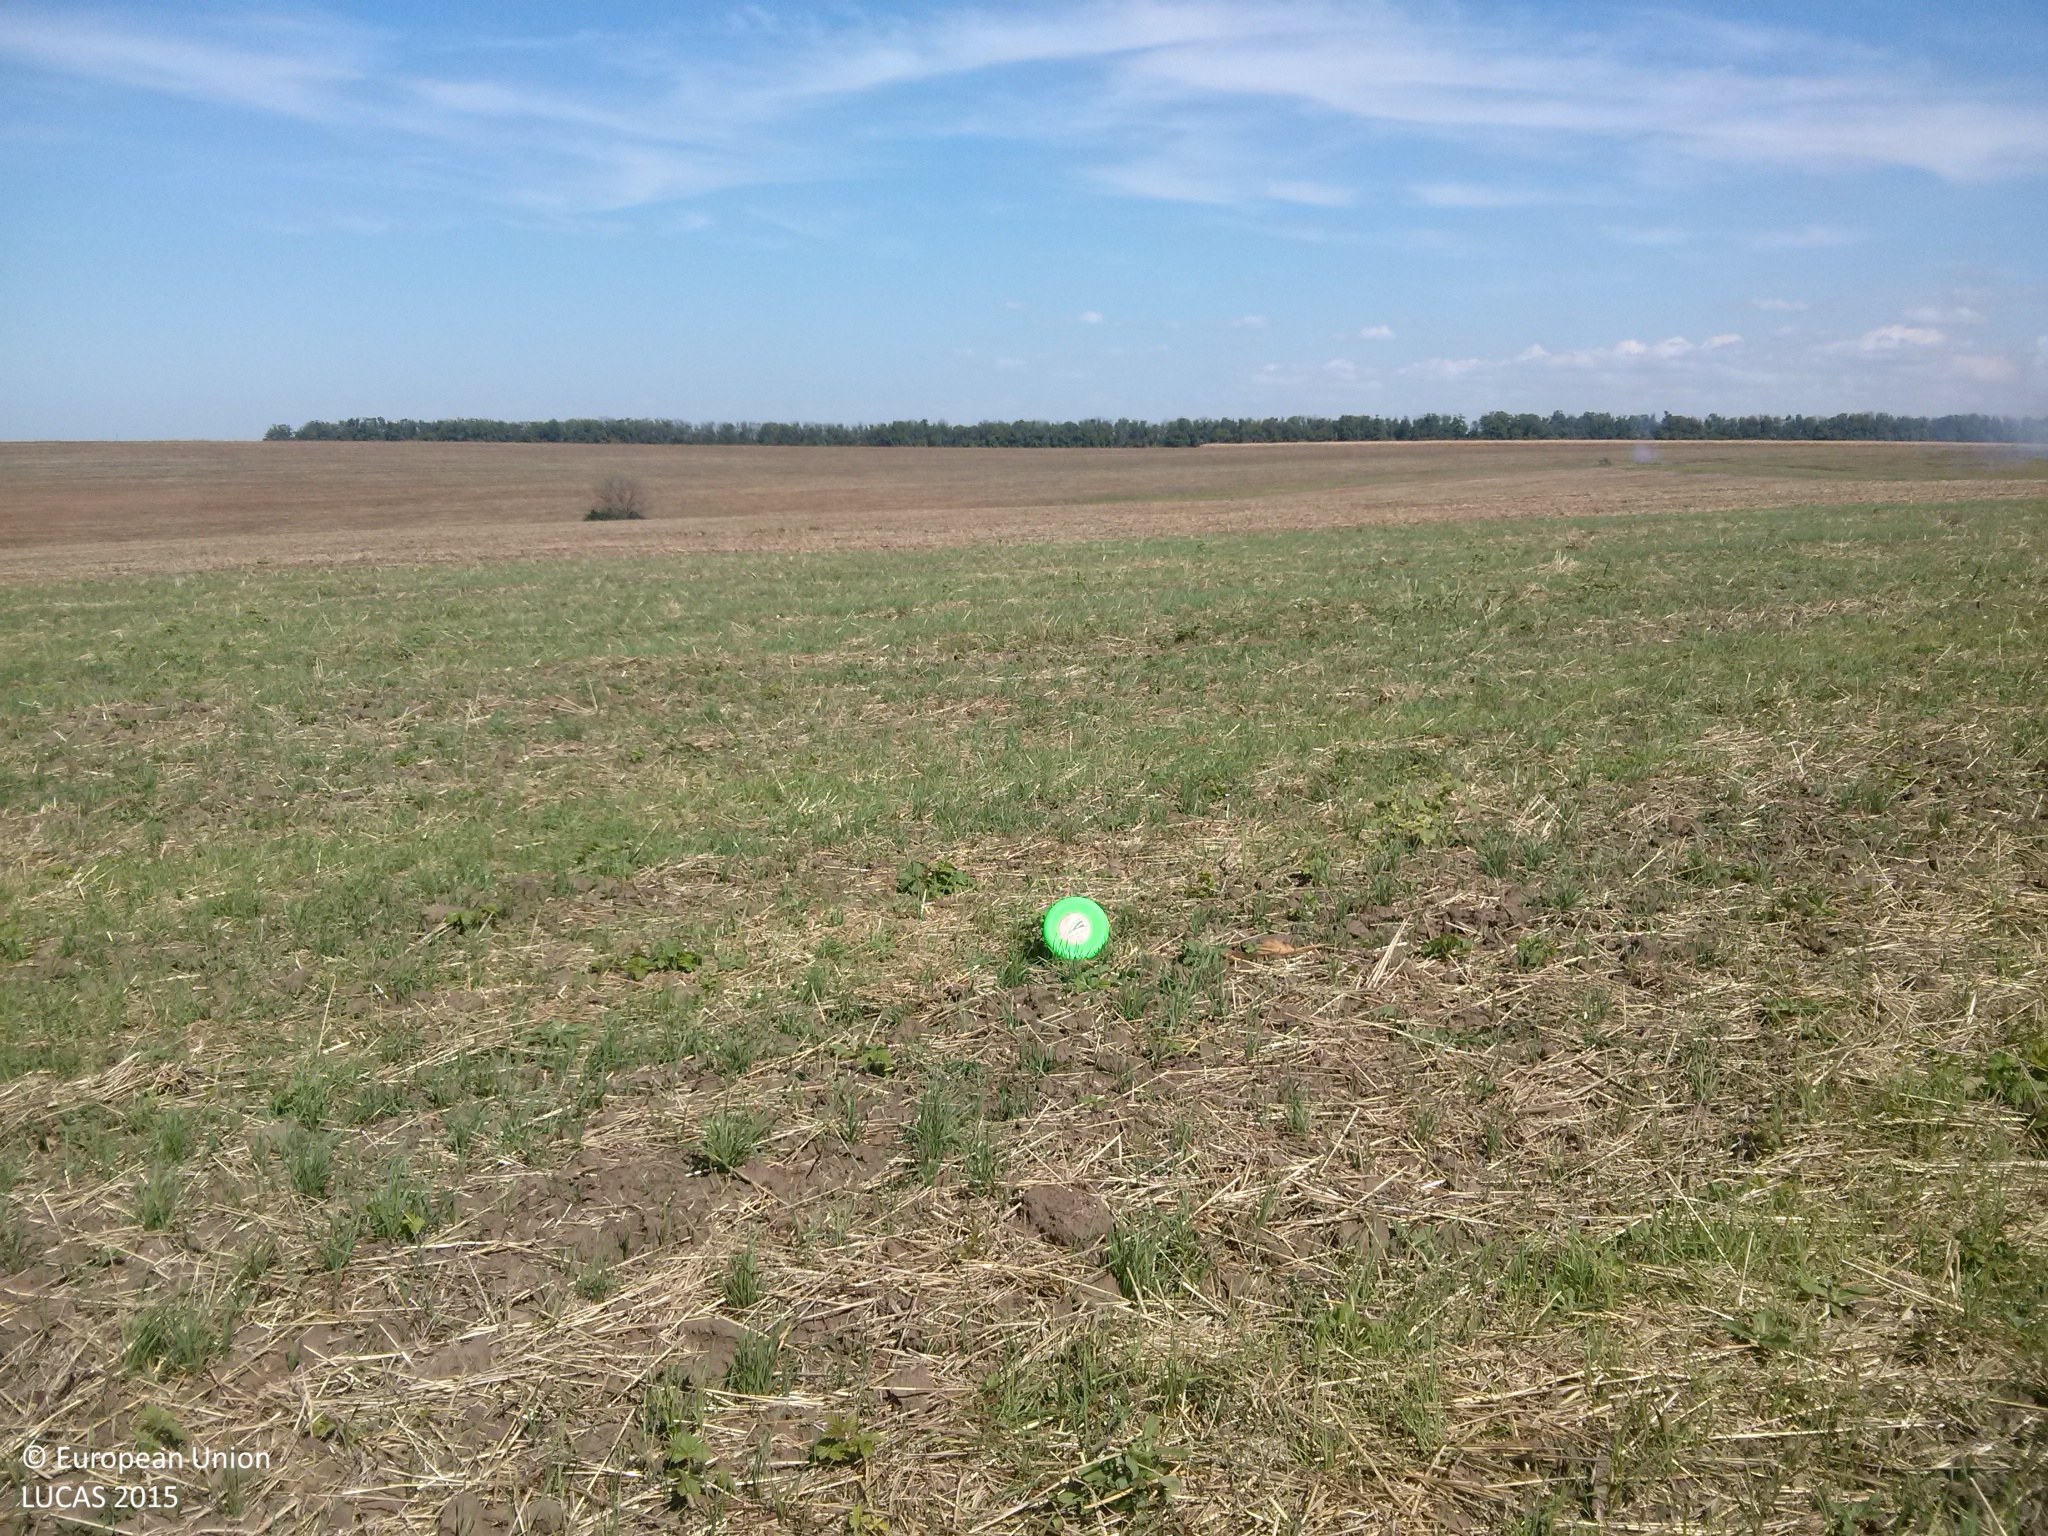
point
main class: Cropland
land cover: Common wheat
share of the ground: < 10 %
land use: Agriculture (excluding fallow land and kitchen gardens)
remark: Harvested field
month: September
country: BG
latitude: 43.6757
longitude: 26.4152
